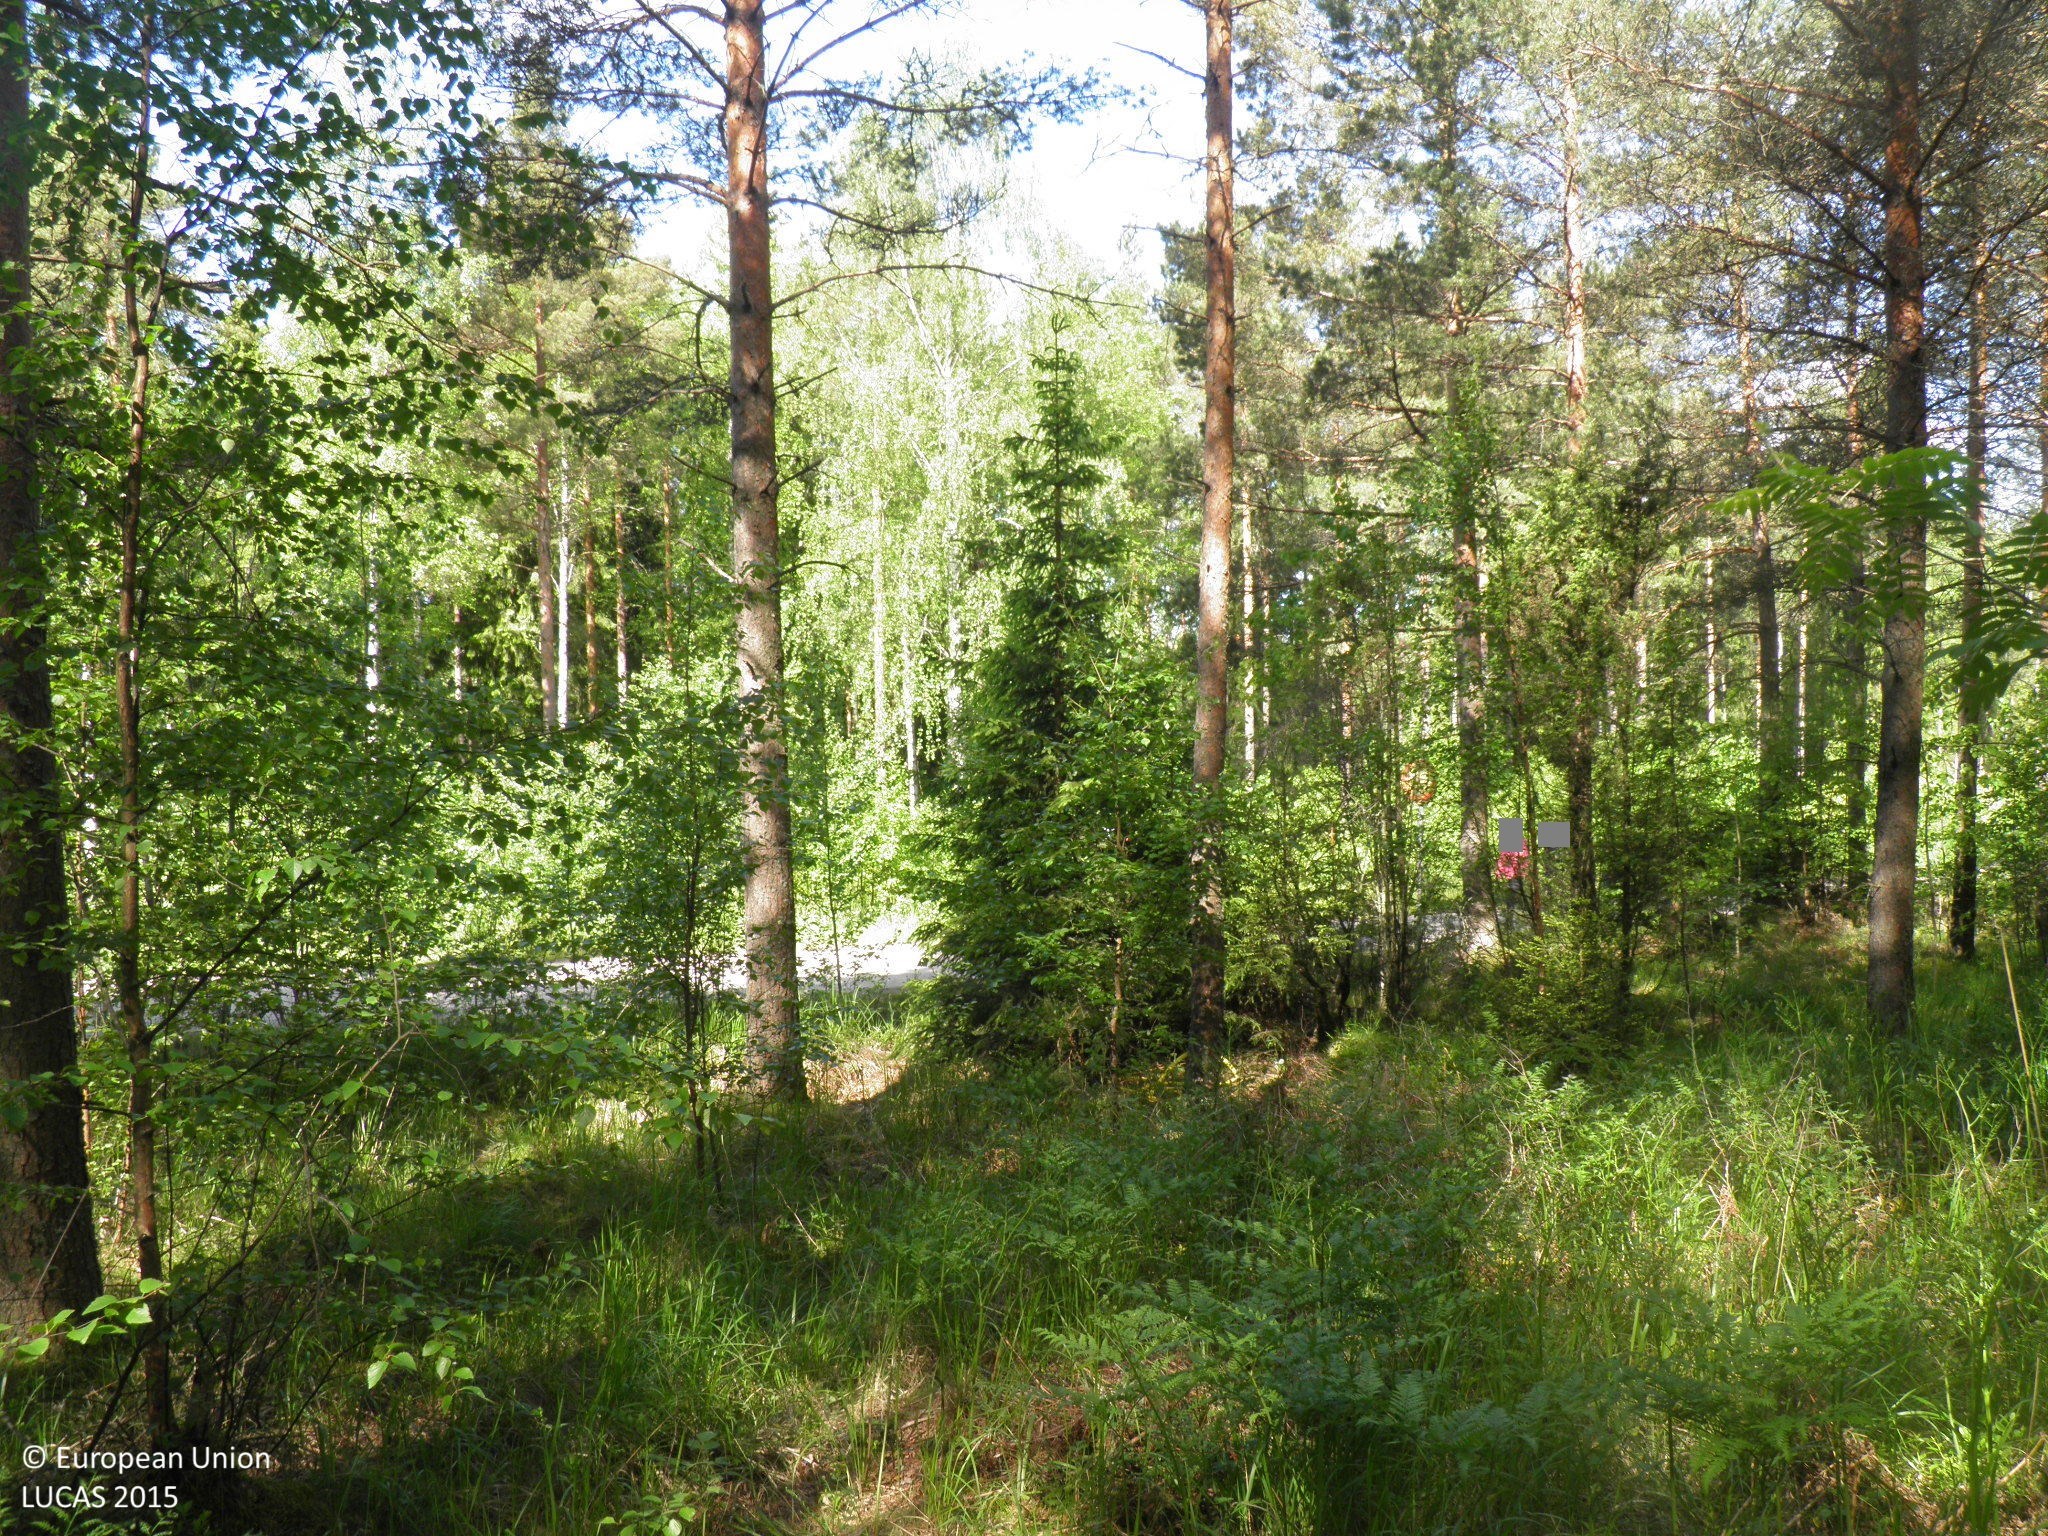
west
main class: Woodland
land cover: Pine dominated coniferous woodland
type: boreal forest
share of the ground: > 75 %
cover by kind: coniferous forest trees 70 %, broadleaved forest trees 10 %, herbaceous plants 10 %, lichens and mosses 10 %
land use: Forestry
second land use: Amenities, museums, leisure
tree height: > 5 m
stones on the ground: 25 - 50 %
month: June
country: FI
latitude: 60.4260
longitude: 22.6978
